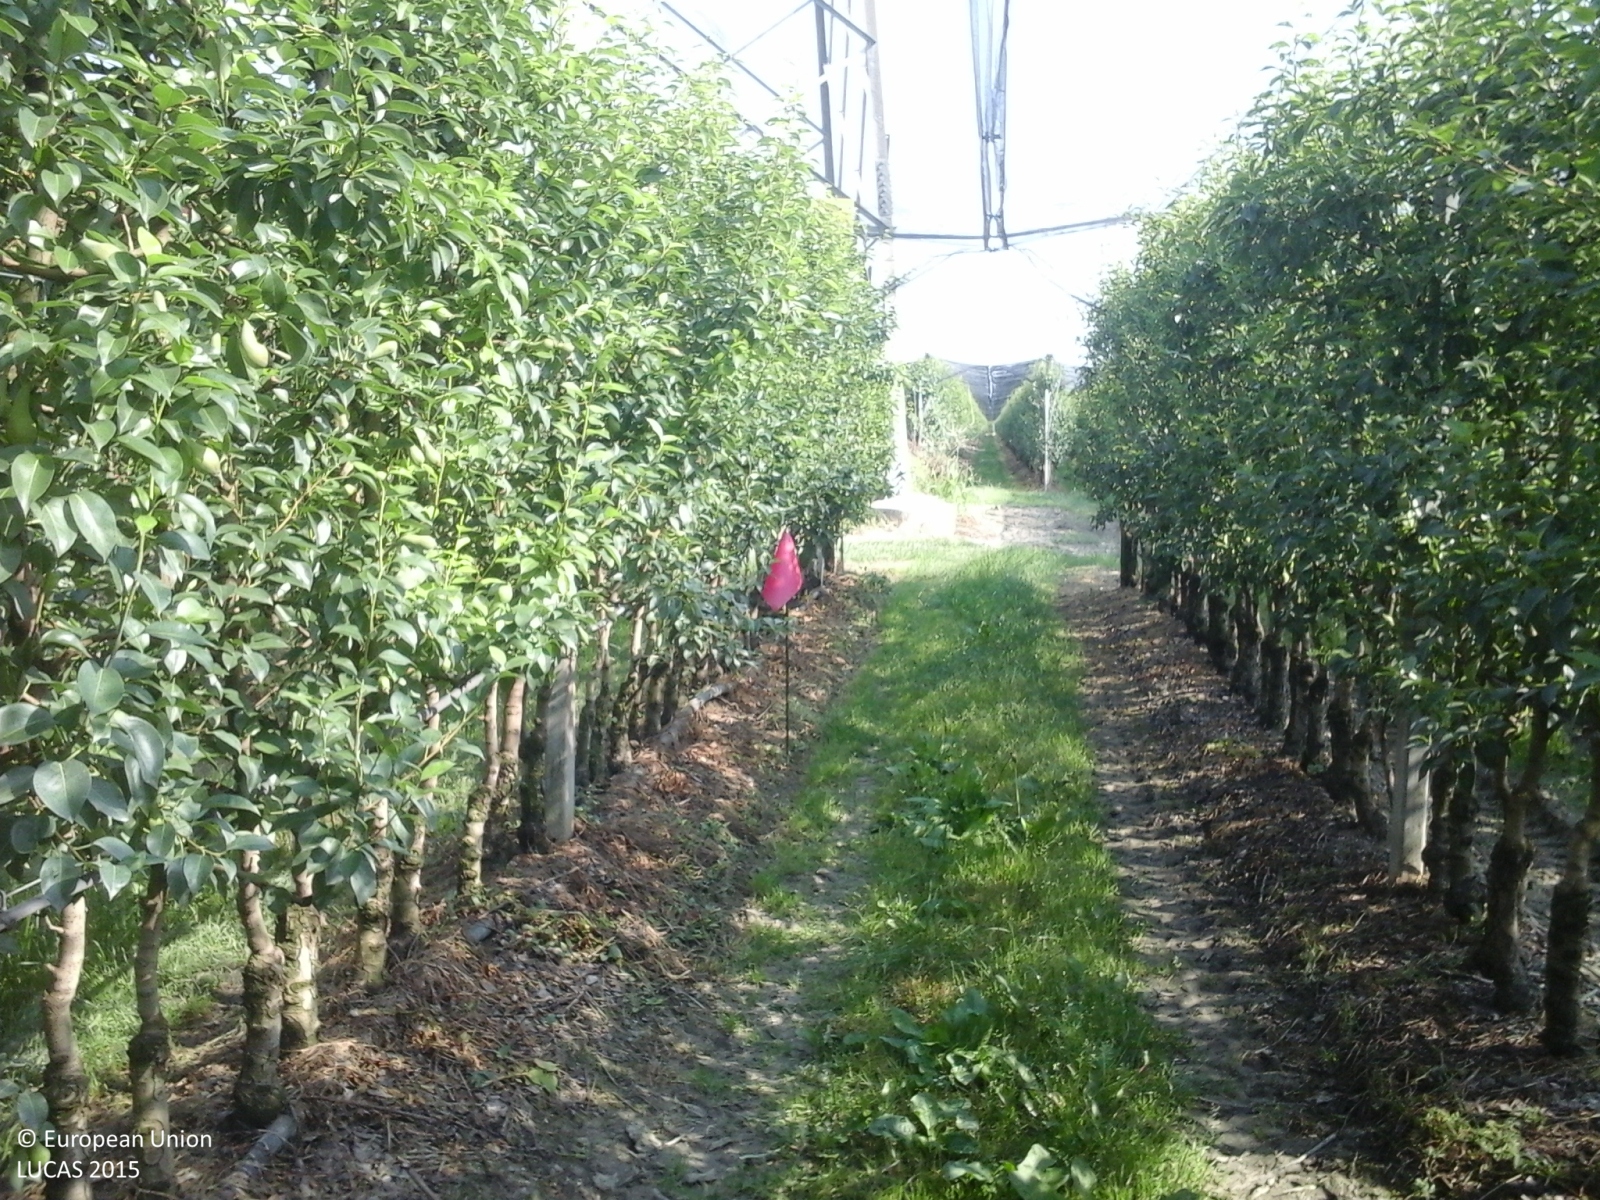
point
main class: Cropland
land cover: Pear fruit
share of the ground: 50 - 75 %
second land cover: Grassland without tree/shrub cover
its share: 50 - 75 %
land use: Agriculture (excluding fallow land and kitchen gardens)
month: May
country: IT
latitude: 44.8420
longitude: 11.6793
